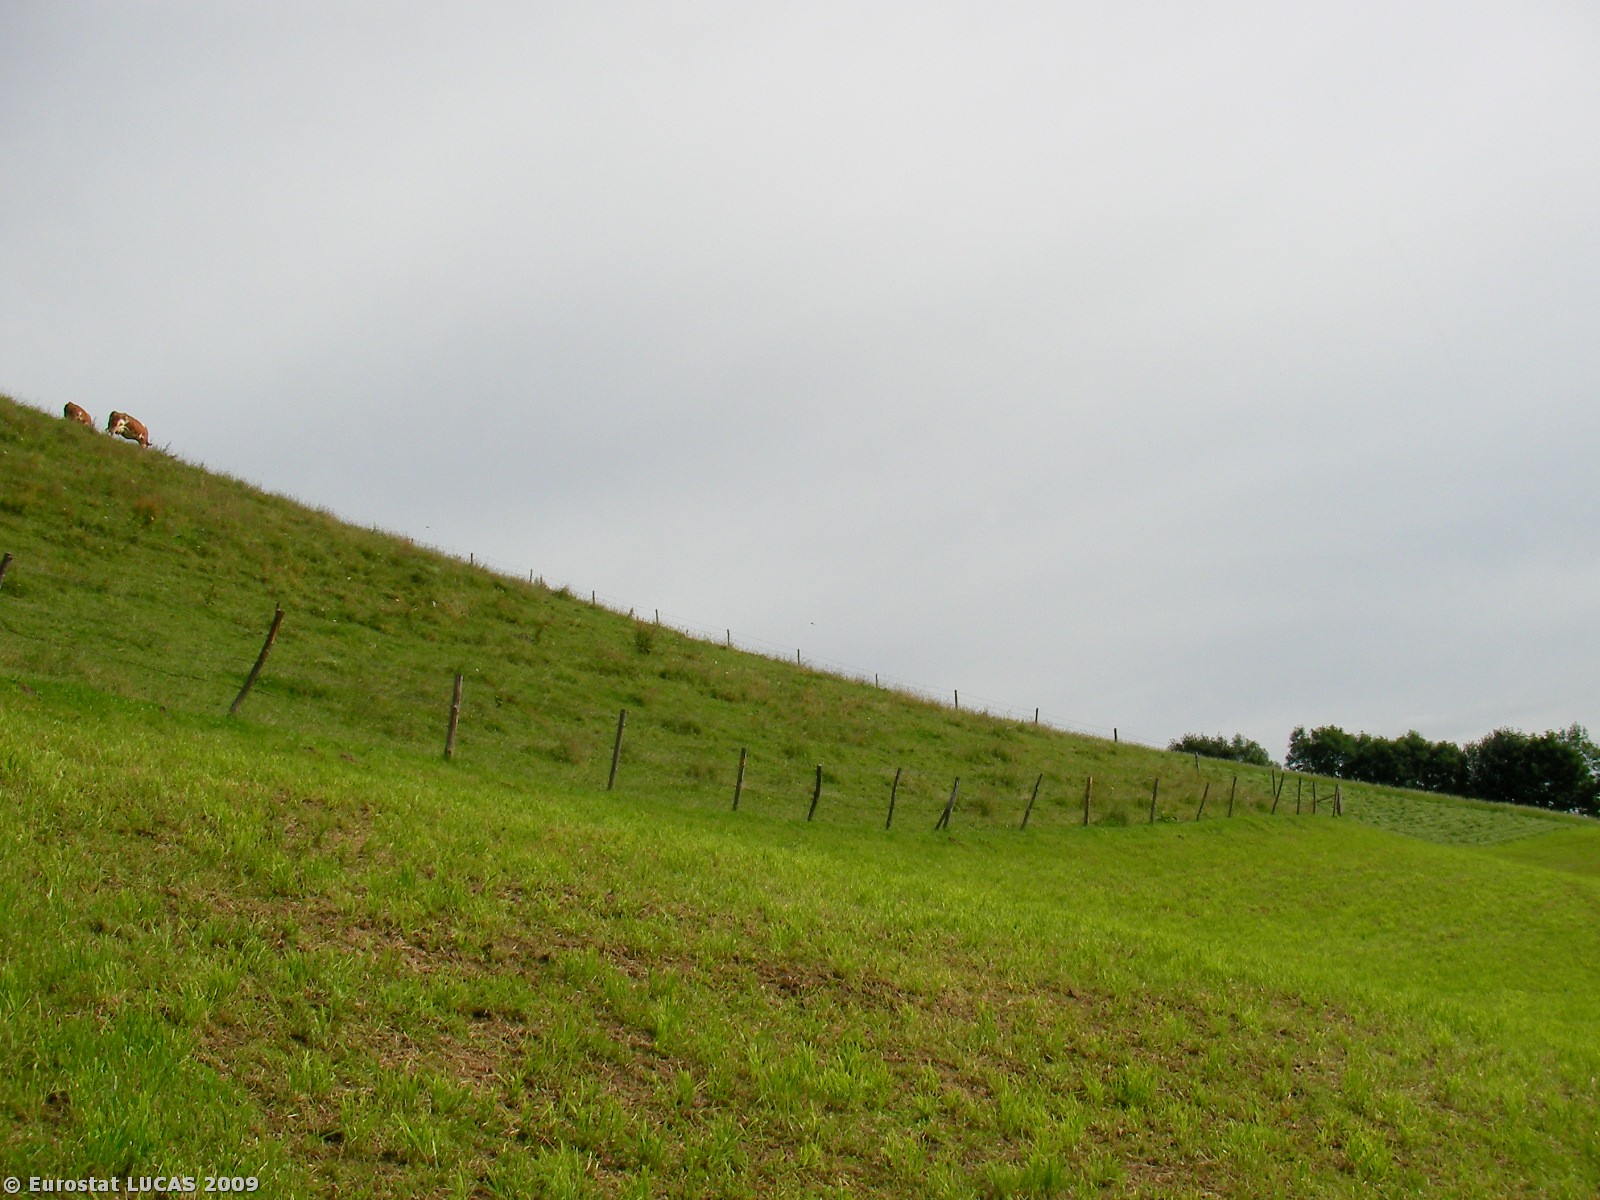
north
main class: Grassland
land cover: Grassland without tree/shrub cover
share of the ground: > 75 %
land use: Agriculture (excluding fallow land and kitchen gardens)
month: July
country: AT
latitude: 47.3582
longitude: 15.6278
